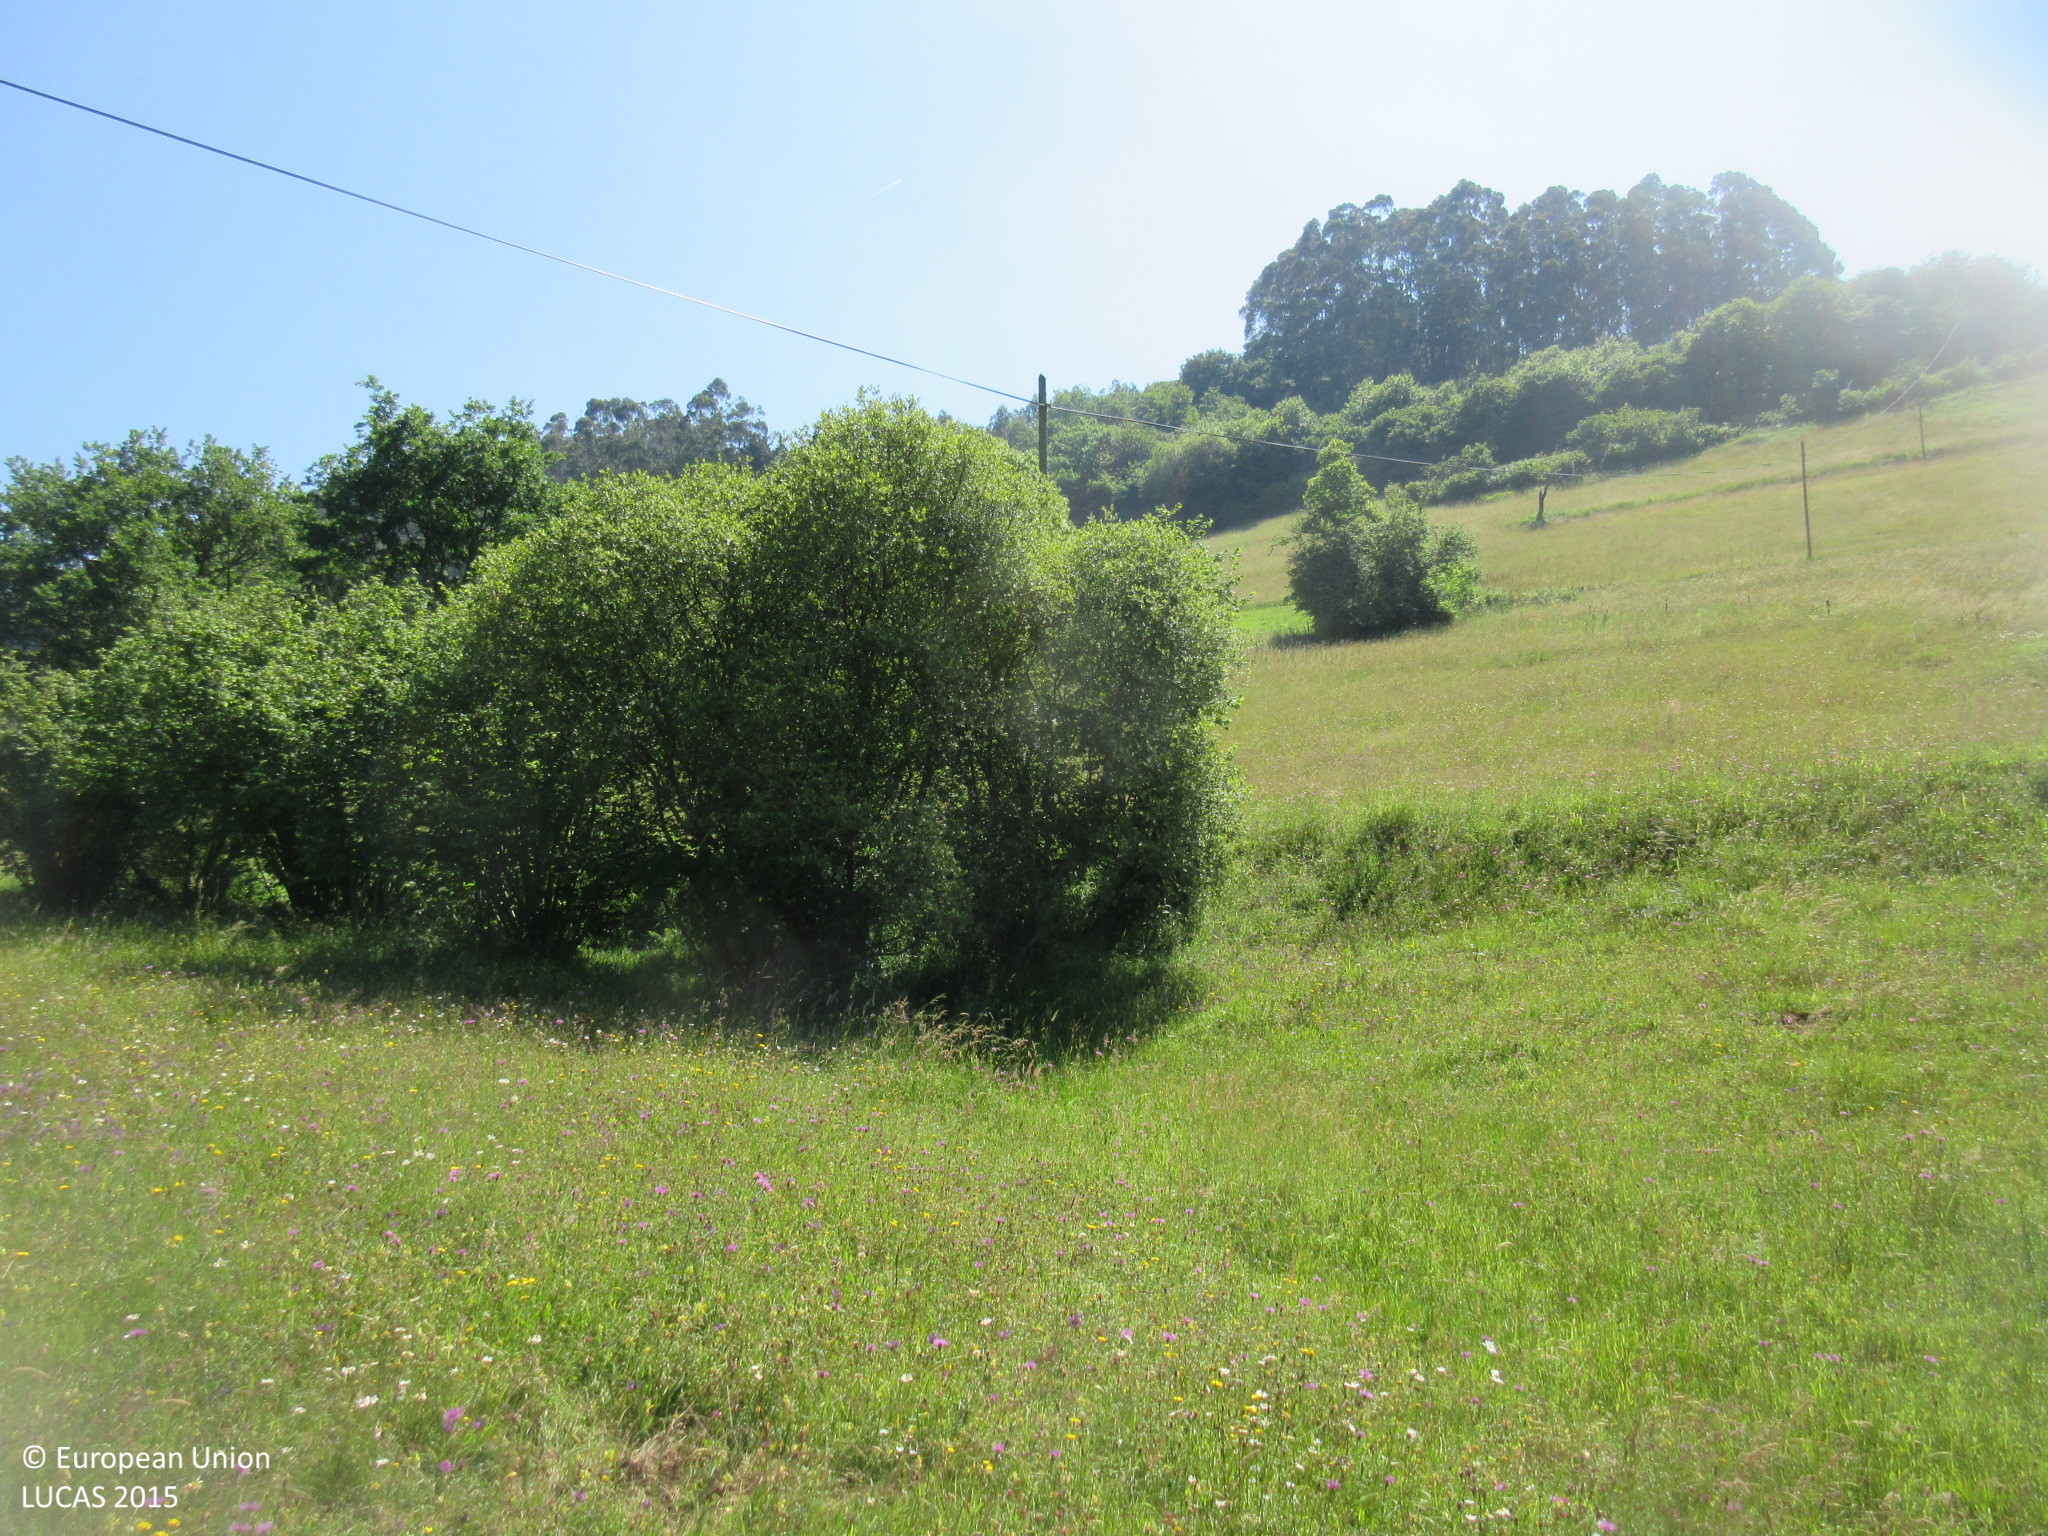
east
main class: Grassland
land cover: Grassland without tree/shrub cover
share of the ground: > 75 %
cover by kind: herbaceous plants 100 %
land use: Agriculture (excluding fallow land and kitchen gardens)
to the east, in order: Grassland without tree/shrub cover; Electric lines; Grassland without tree/shrub cover; Single bushes/trees; Grassland without tree/shrub cover; Broadleaved woodland; Grass margins; Paved roads, cycling and walking lanes; Grass margins; Broadleaved woodland
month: June
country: ES
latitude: 43.4764
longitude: -6.0539
